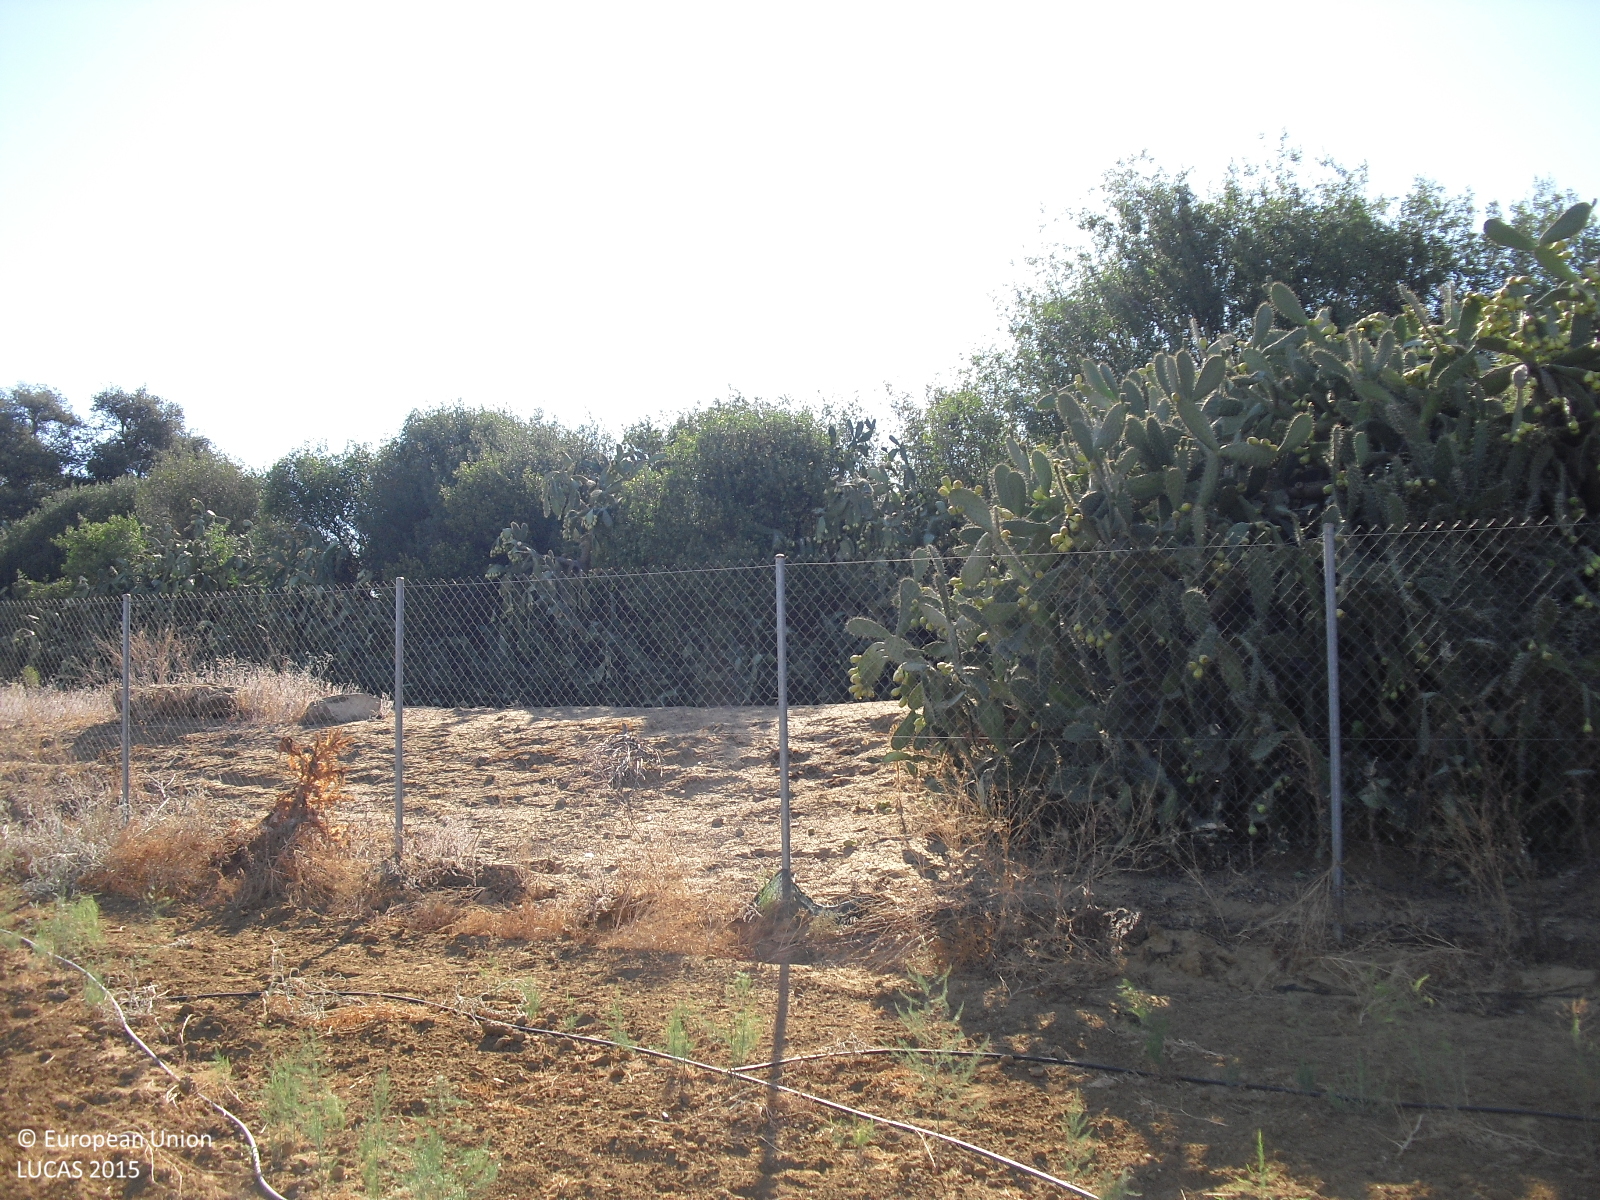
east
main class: Cropland
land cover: Other fresh vegetables
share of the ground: < 10 %
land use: Agriculture (excluding fallow land and kitchen gardens)
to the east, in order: Other fresh vegetables; Grass margins; Fences; Shrubland without tree cover; Tracks; Shrubland without tree cover; Fences; Broadleaved woodland
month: August
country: ES
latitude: 37.2863
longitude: -5.4550
